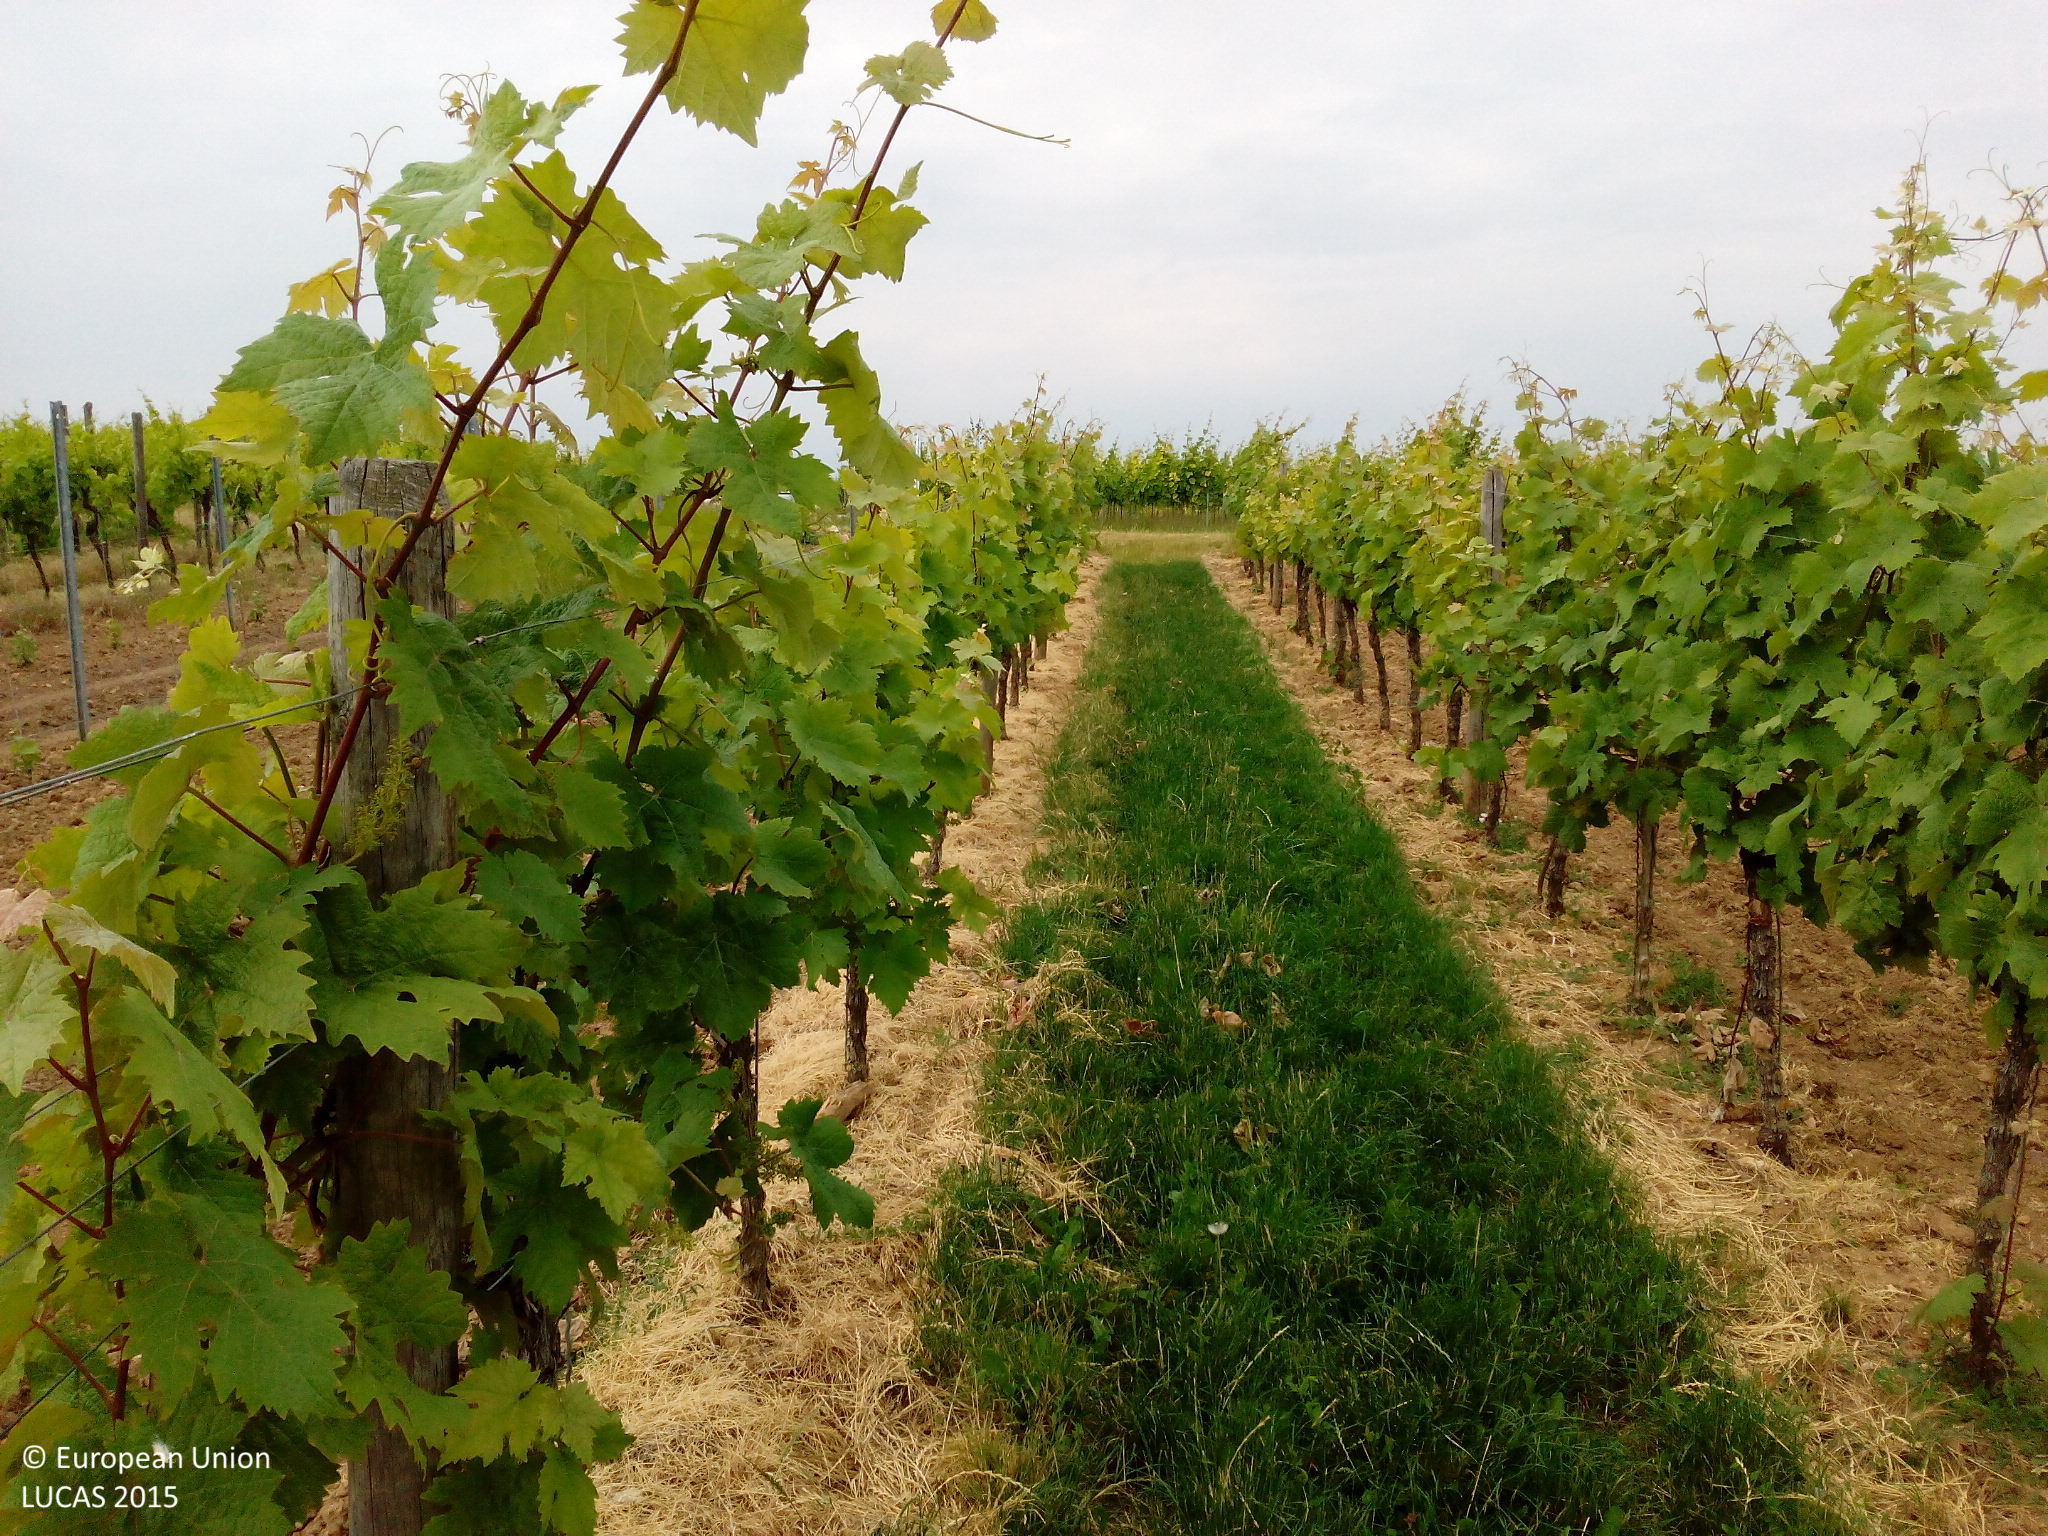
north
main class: Cropland
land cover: Vineyards
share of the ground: 10 - 25 %
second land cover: Spontaneously vegetated surfaces
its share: 25 - 50 %
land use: Agriculture (excluding fallow land and kitchen gardens)
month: June
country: DE
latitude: 49.5039
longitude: 8.1639
